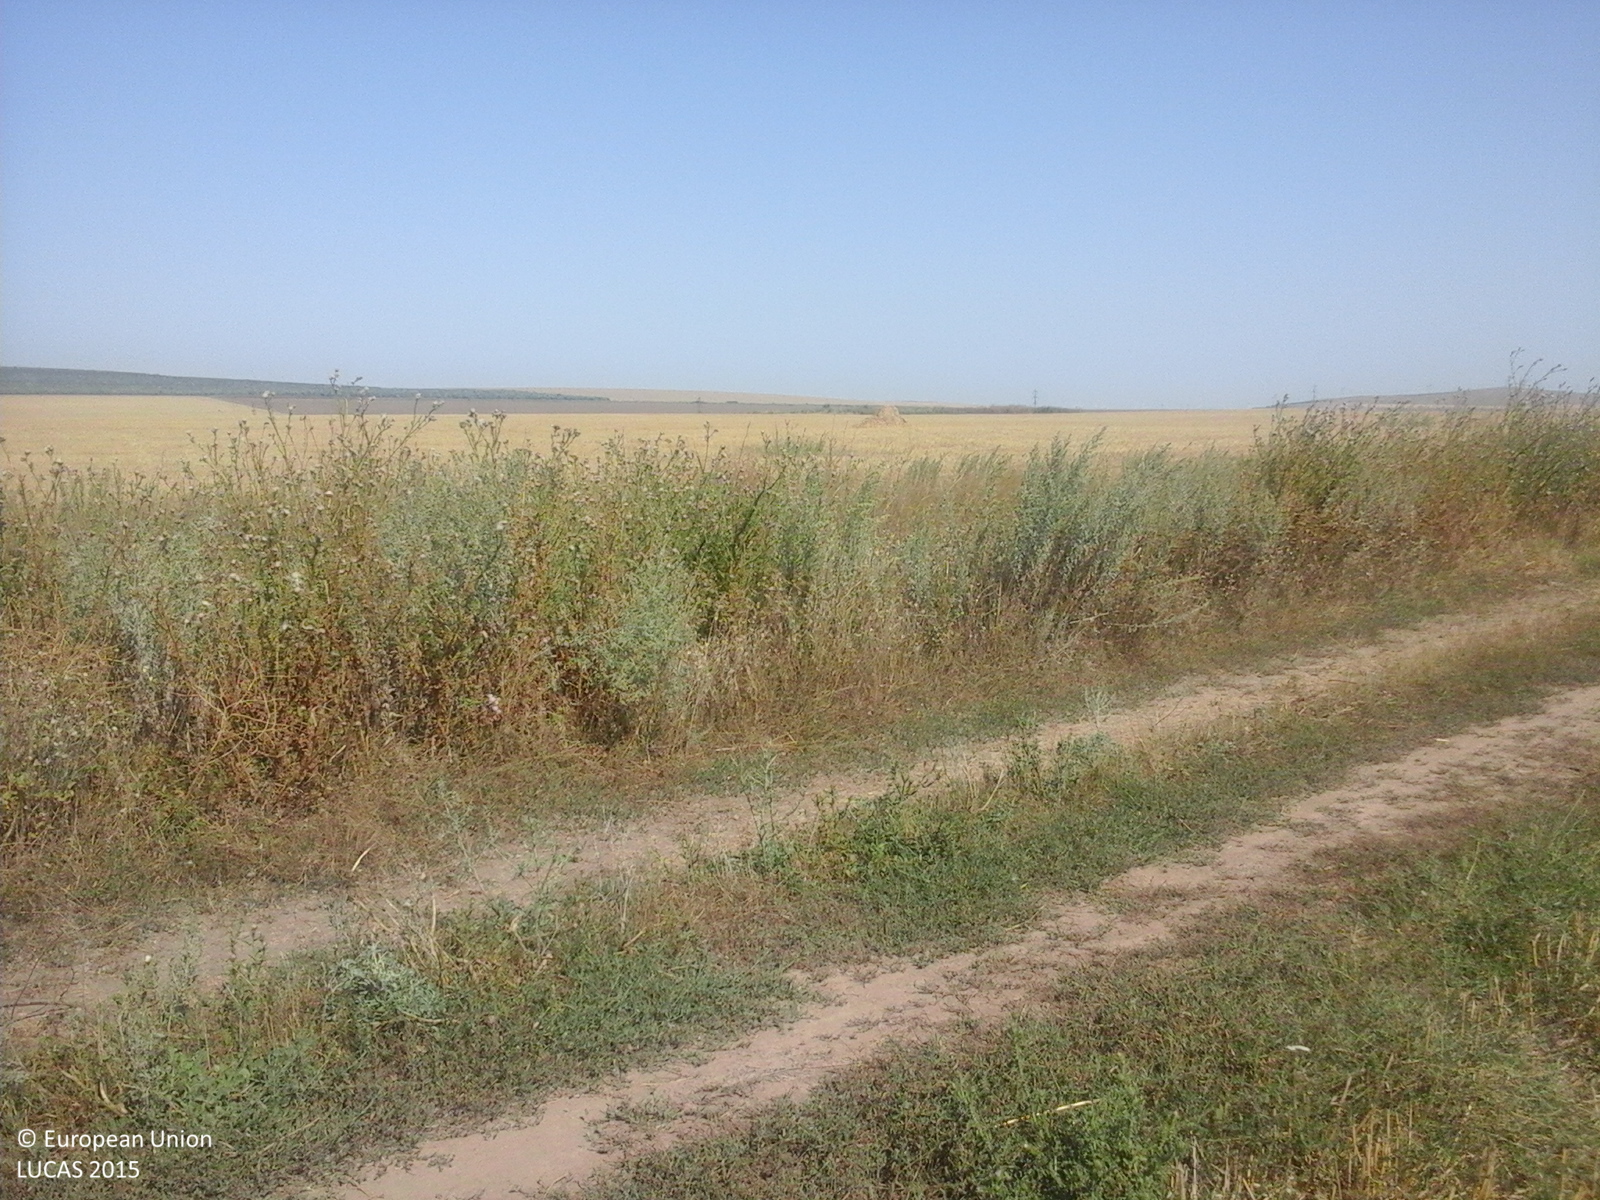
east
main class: Cropland
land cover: Barley
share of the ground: > 75 %
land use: Agriculture (excluding fallow land and kitchen gardens)
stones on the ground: < 10 %
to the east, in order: Barley; Tracks; Spontaneously vegetated surfaces; Ditches and canals; Spontaneously vegetated surfaces; Tracks; Grass margins; Common wheat
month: August
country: RO
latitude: 44.5636
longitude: 28.1295
